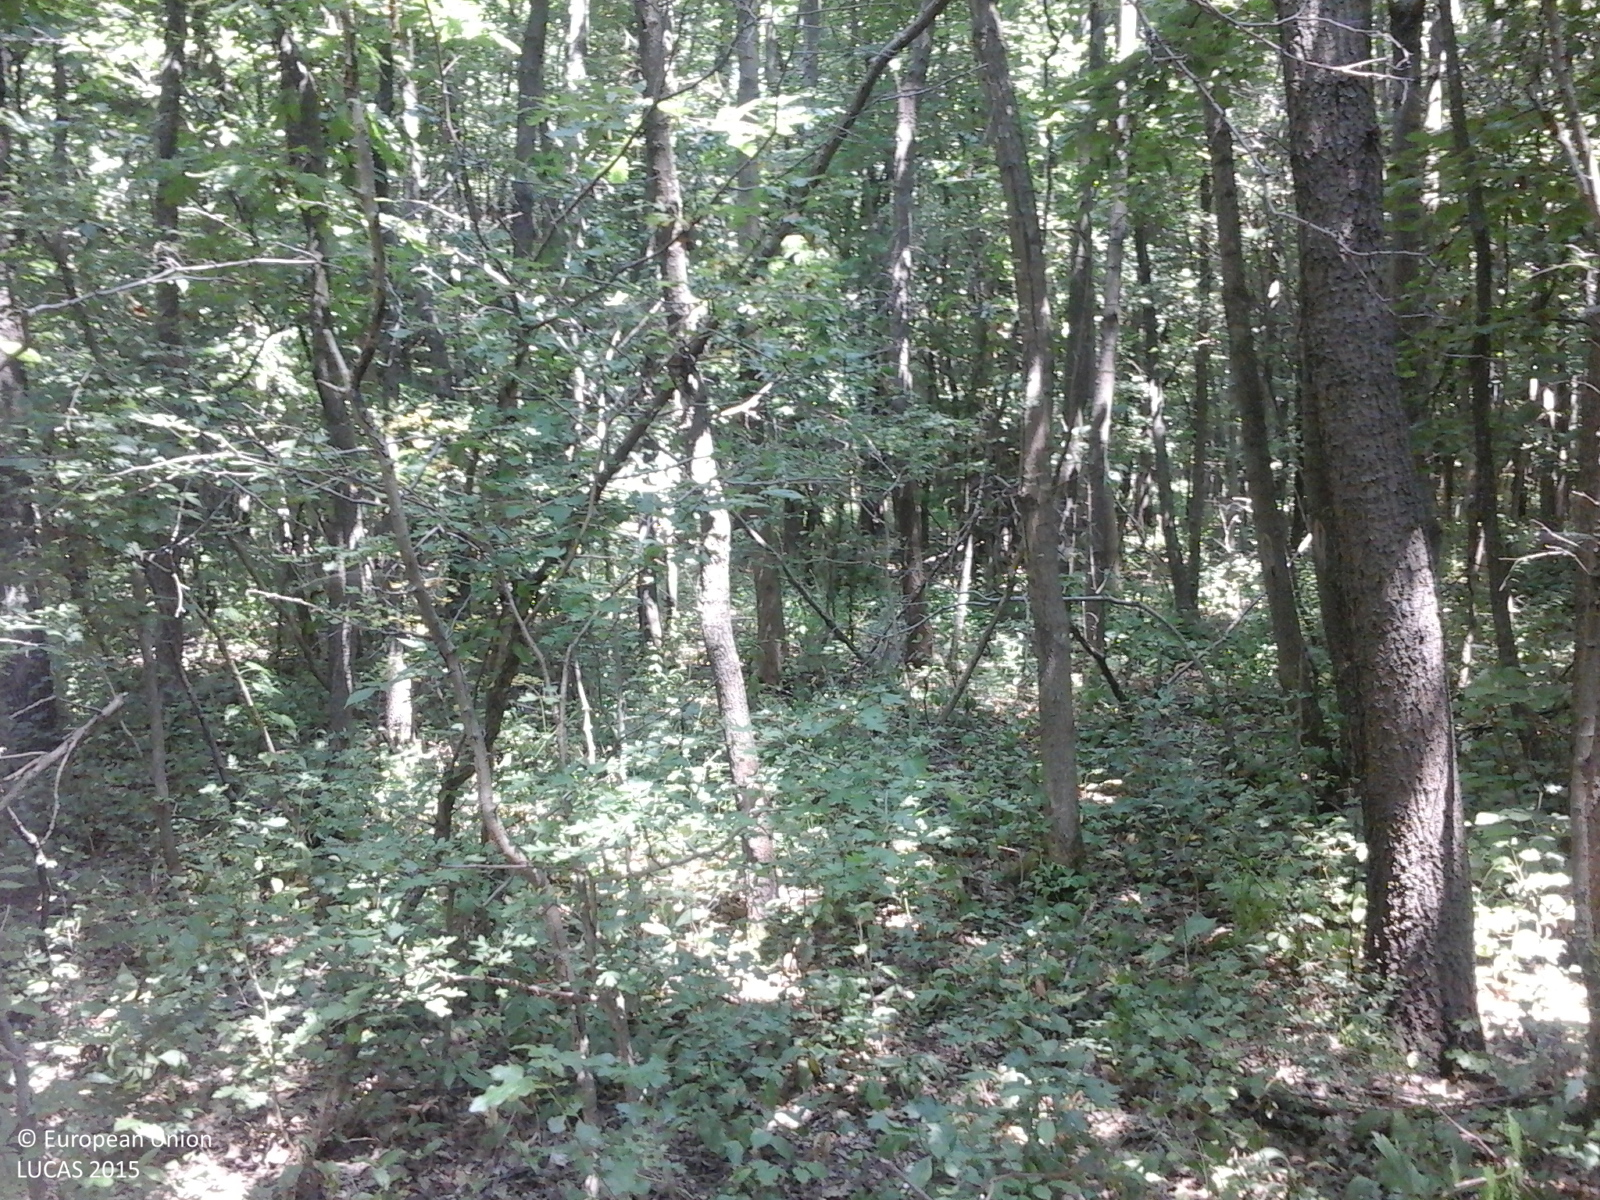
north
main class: Woodland
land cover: Broadleaved woodland
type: mesophytic deciduous forest
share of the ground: > 75 %
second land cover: Spontaneously vegetated surfaces
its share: < 10 %
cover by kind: broadleaved forest trees 90 %, herbaceous plants 10 %
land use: Forestry
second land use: Agriculture (excluding fallow land and kitchen gardens)
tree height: > 5 m
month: July
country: RO
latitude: 44.5166
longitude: 25.3745
